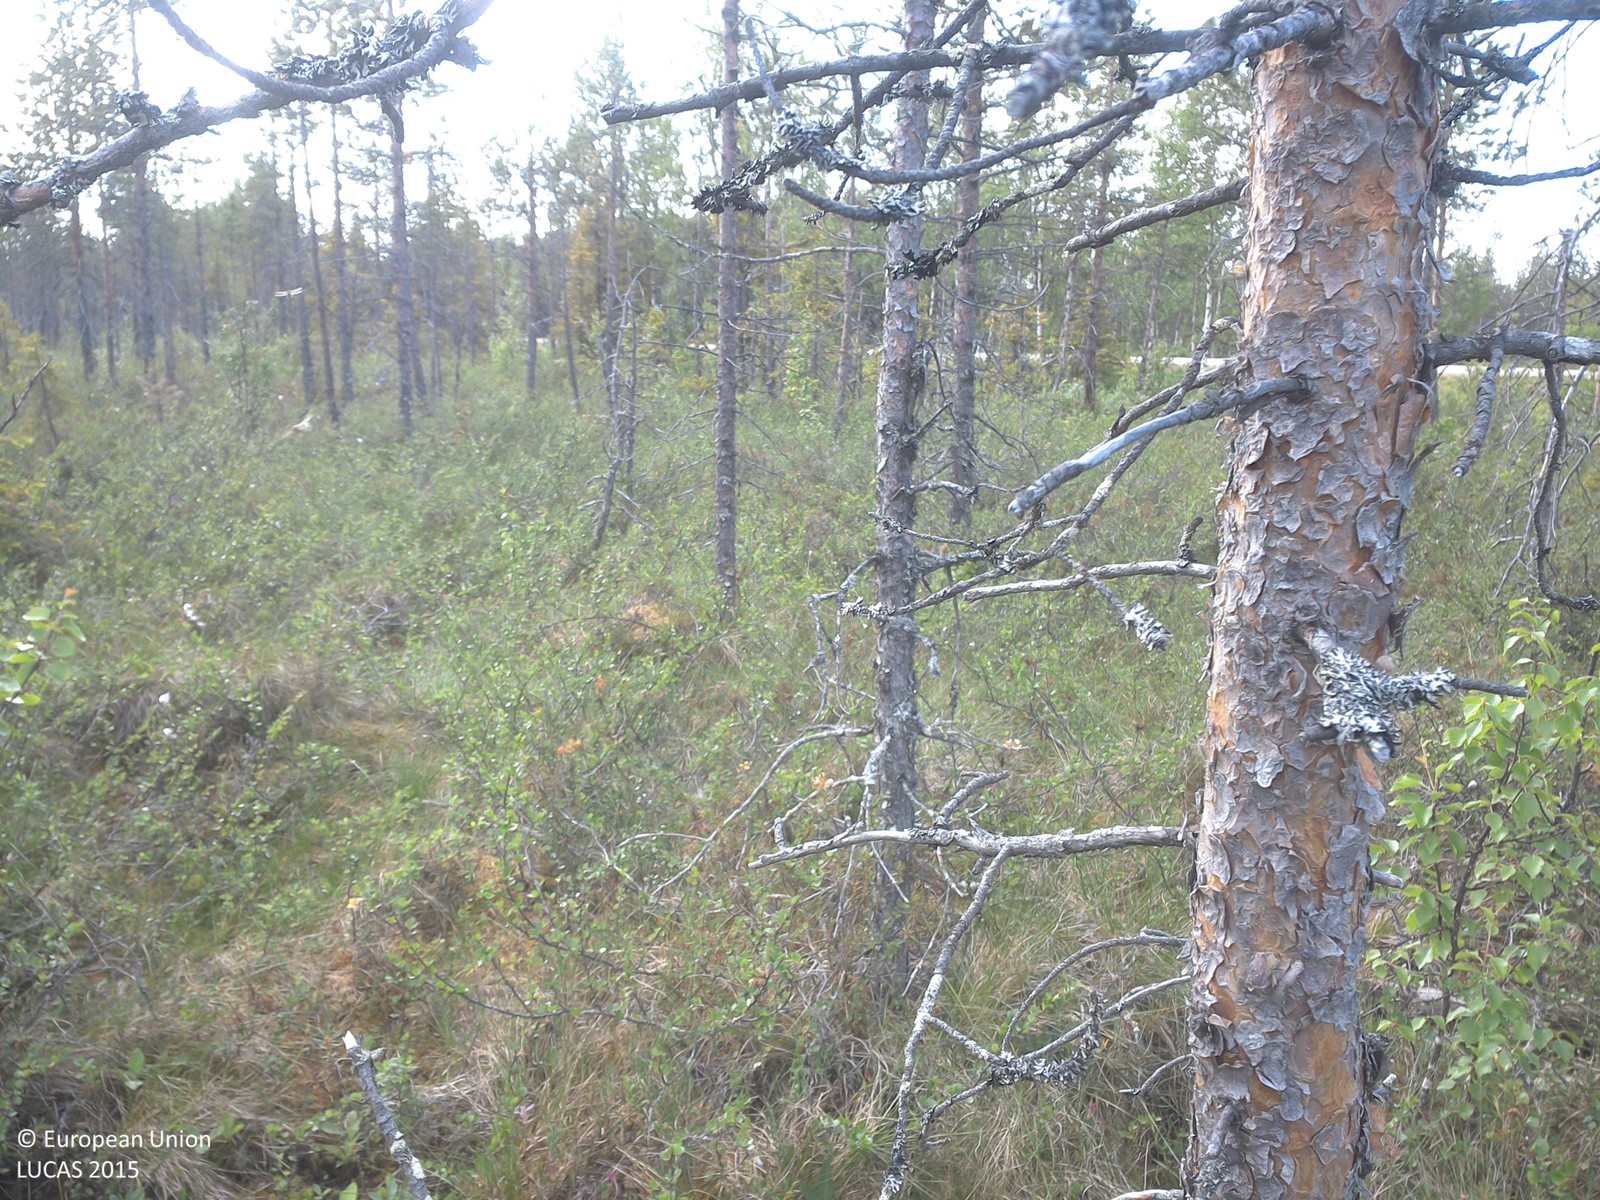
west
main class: Woodland
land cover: Pine dominated coniferous woodland
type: boreal forest
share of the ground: 10 - 25 %
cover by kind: shrubs 65 %, coniferous forest trees 15 %, lichens and mosses 15 %, herbaceous plants 5 %
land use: Forestry
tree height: < 5 m
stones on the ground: < 10 %
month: July
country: SE
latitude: 67.4476
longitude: 22.2225
